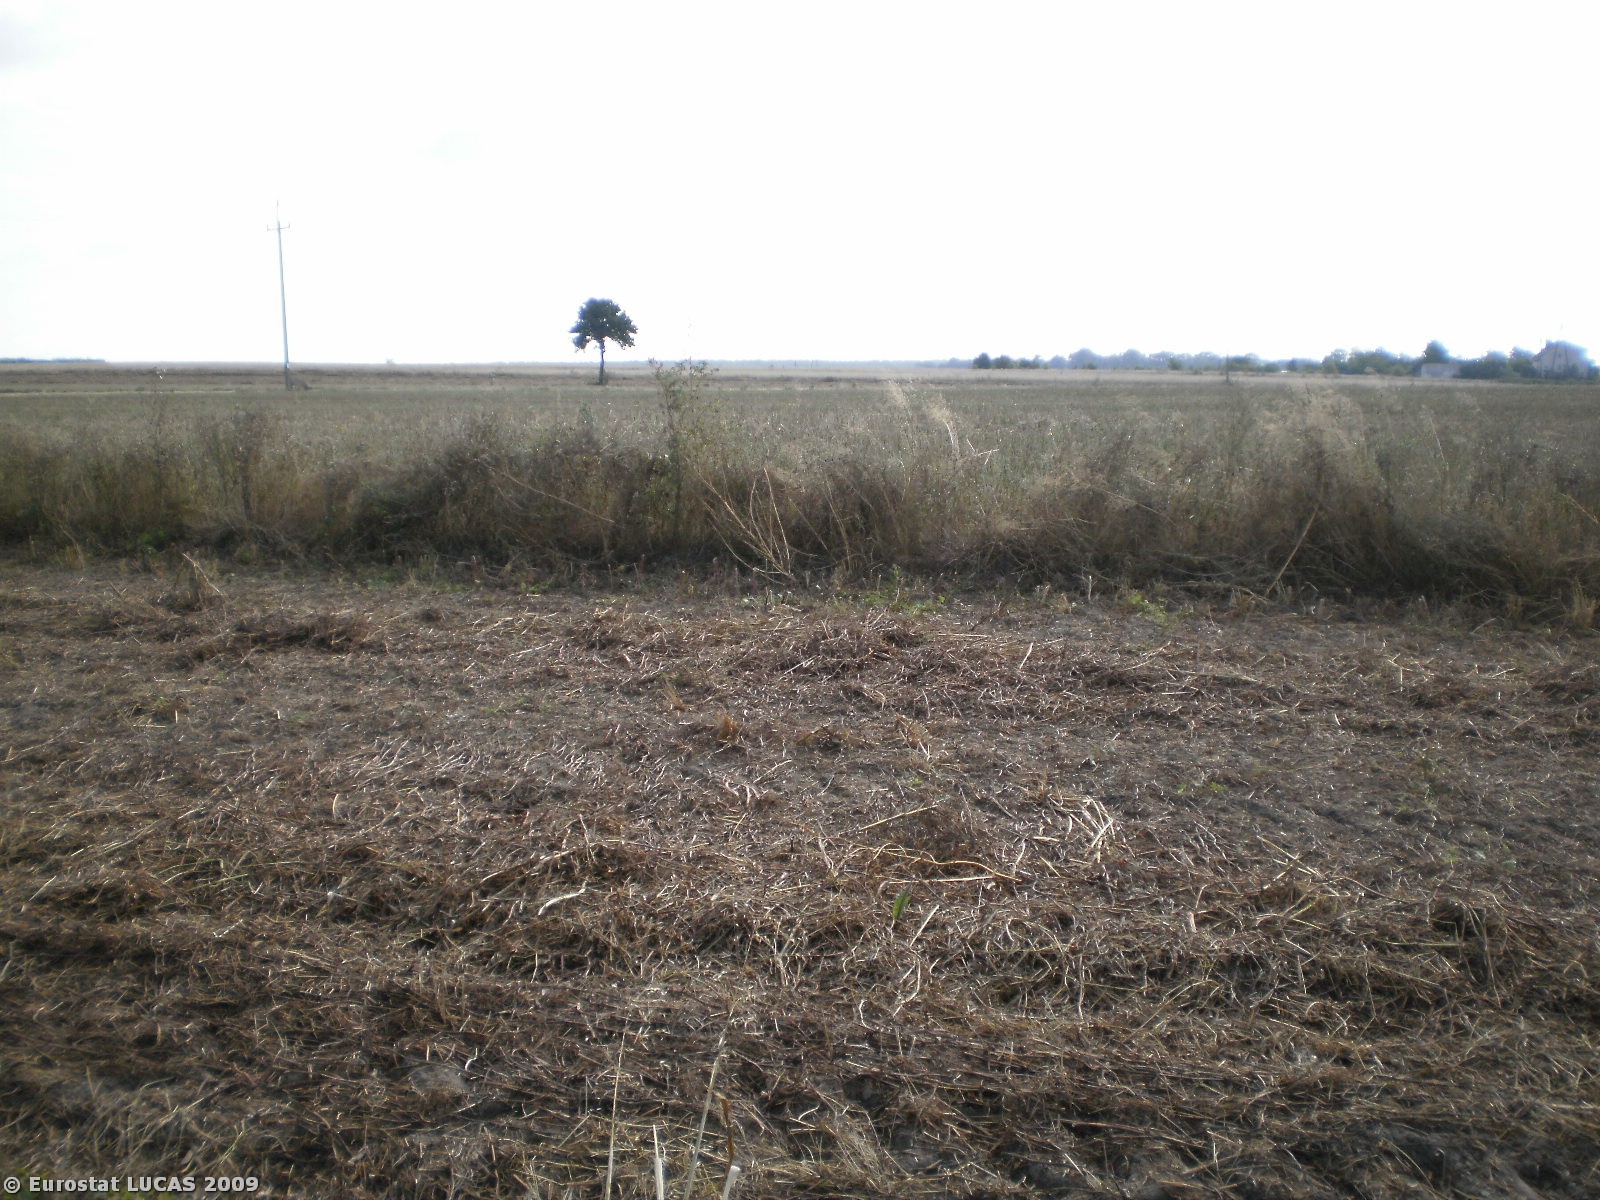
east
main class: Cropland
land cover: Dry pulses
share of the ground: > 75 %
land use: Agriculture (excluding fallow land and kitchen gardens)
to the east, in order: Dry pulses; Grass margins; Oats; Grass margins; Oats; Grass margins; Rye; Electric lines; Rye
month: August
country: PL
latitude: 52.9346
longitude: 21.0092
